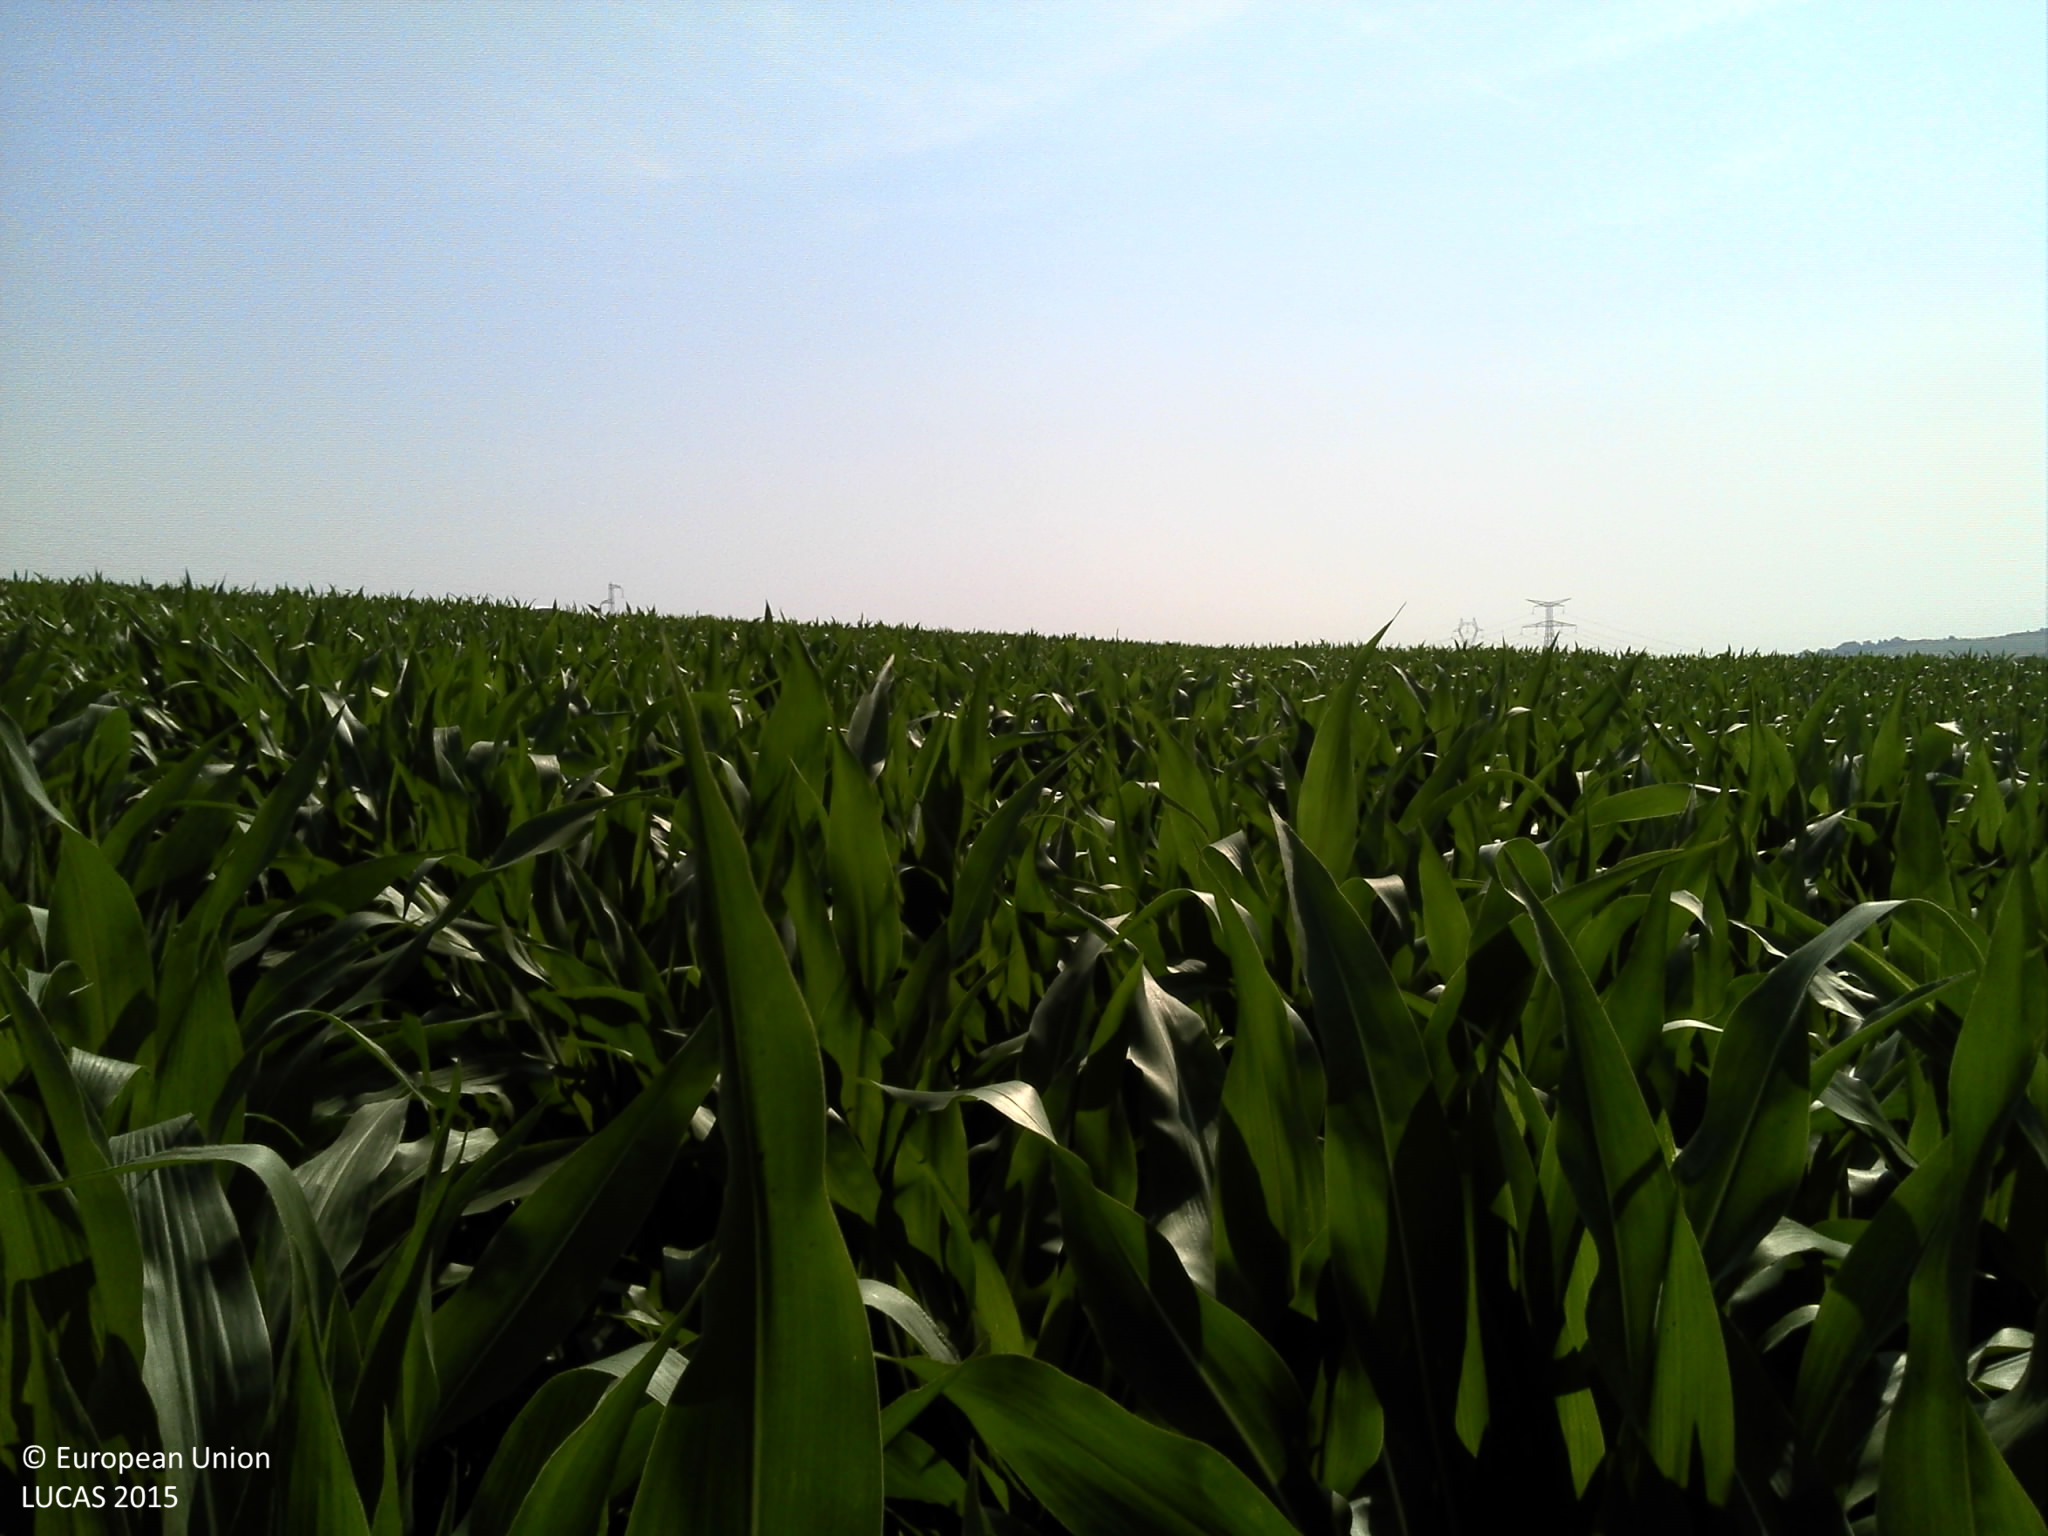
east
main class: Cropland
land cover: Maize
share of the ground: > 75 %
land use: Agriculture (excluding fallow land and kitchen gardens)
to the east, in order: Maize; Grass margins; Tracks; Grass margins; Common wheat
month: July
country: FR
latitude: 49.7982
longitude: 4.4806
